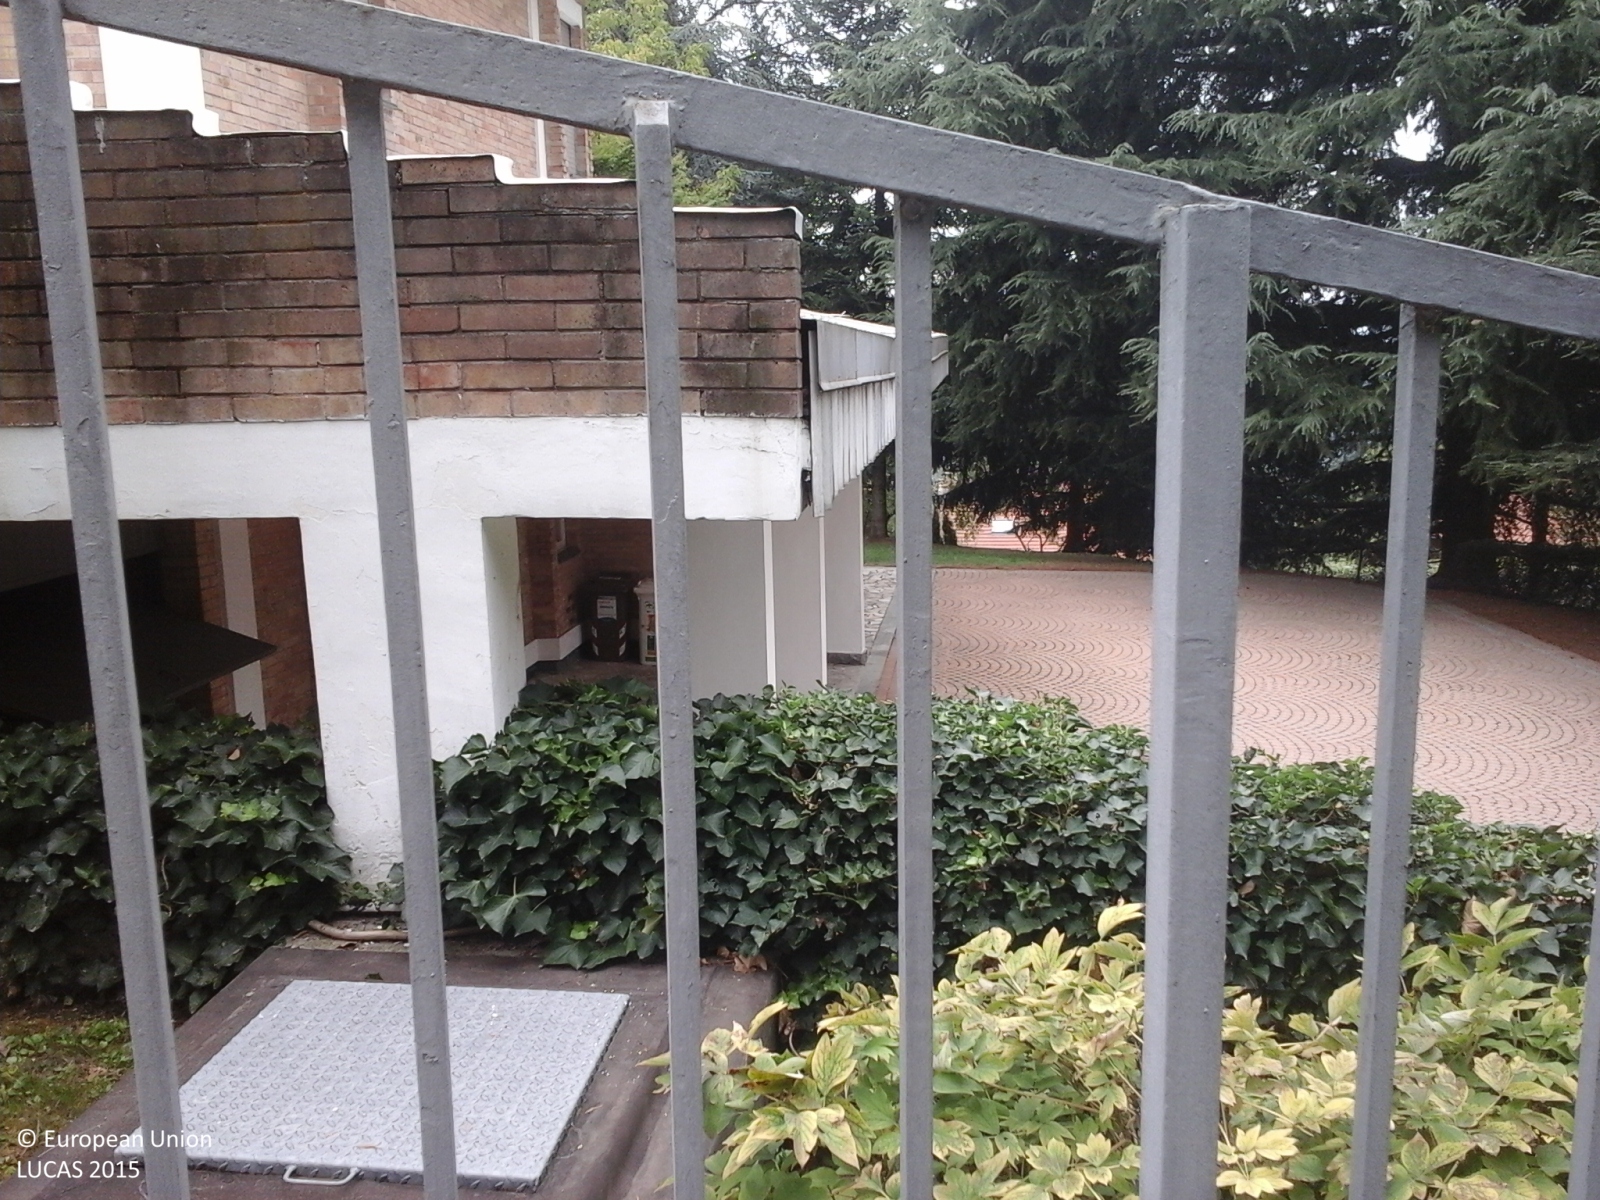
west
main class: Woodland
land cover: Other coniferous woodland
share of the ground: > 75 %
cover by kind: coniferous forest trees 50 %, herbaceous plants 30 %, broadleaved forest trees 10 %, shrubs 10 %
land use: Residential
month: September
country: IT
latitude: 45.0478
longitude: 7.7567
